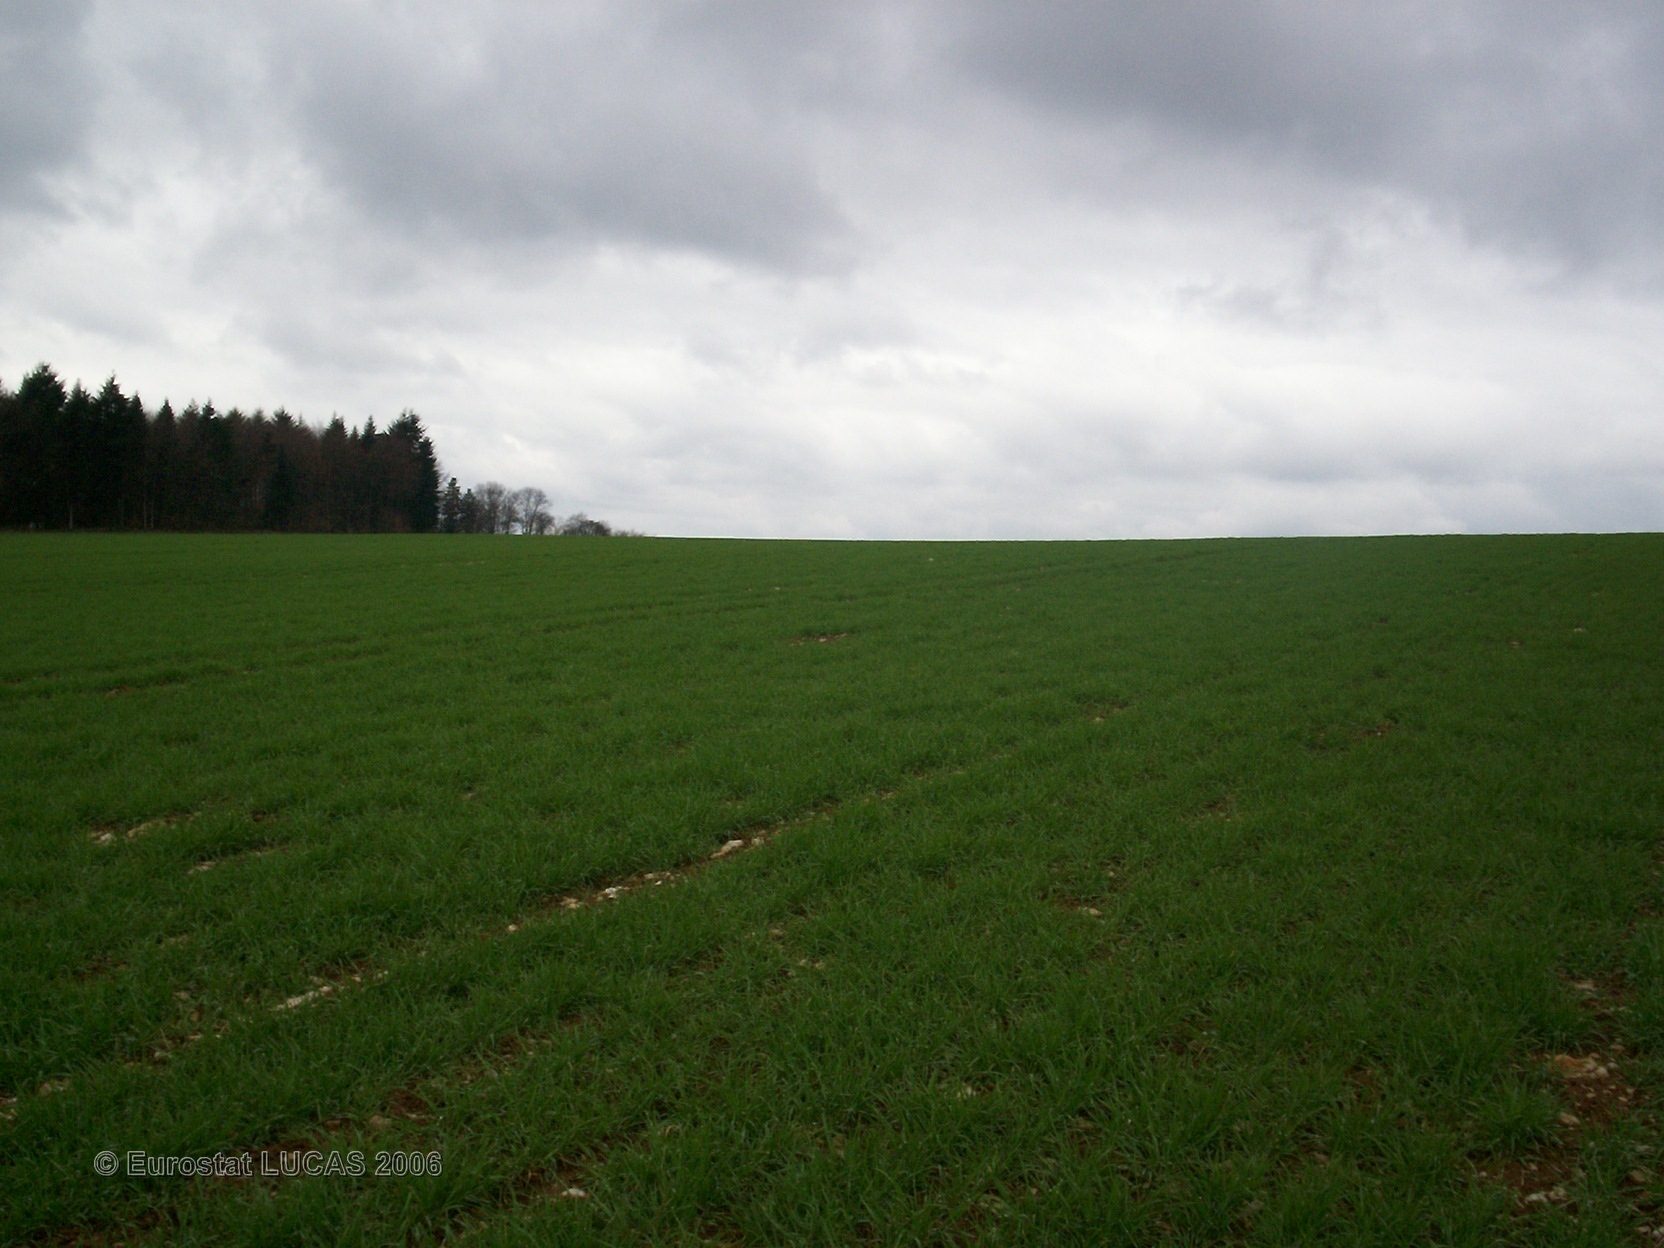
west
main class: Cropland
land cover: Barley
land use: Agriculture (excluding fallow land and kitchen gardens)
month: April
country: FR
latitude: 48.3034
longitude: 4.8889
